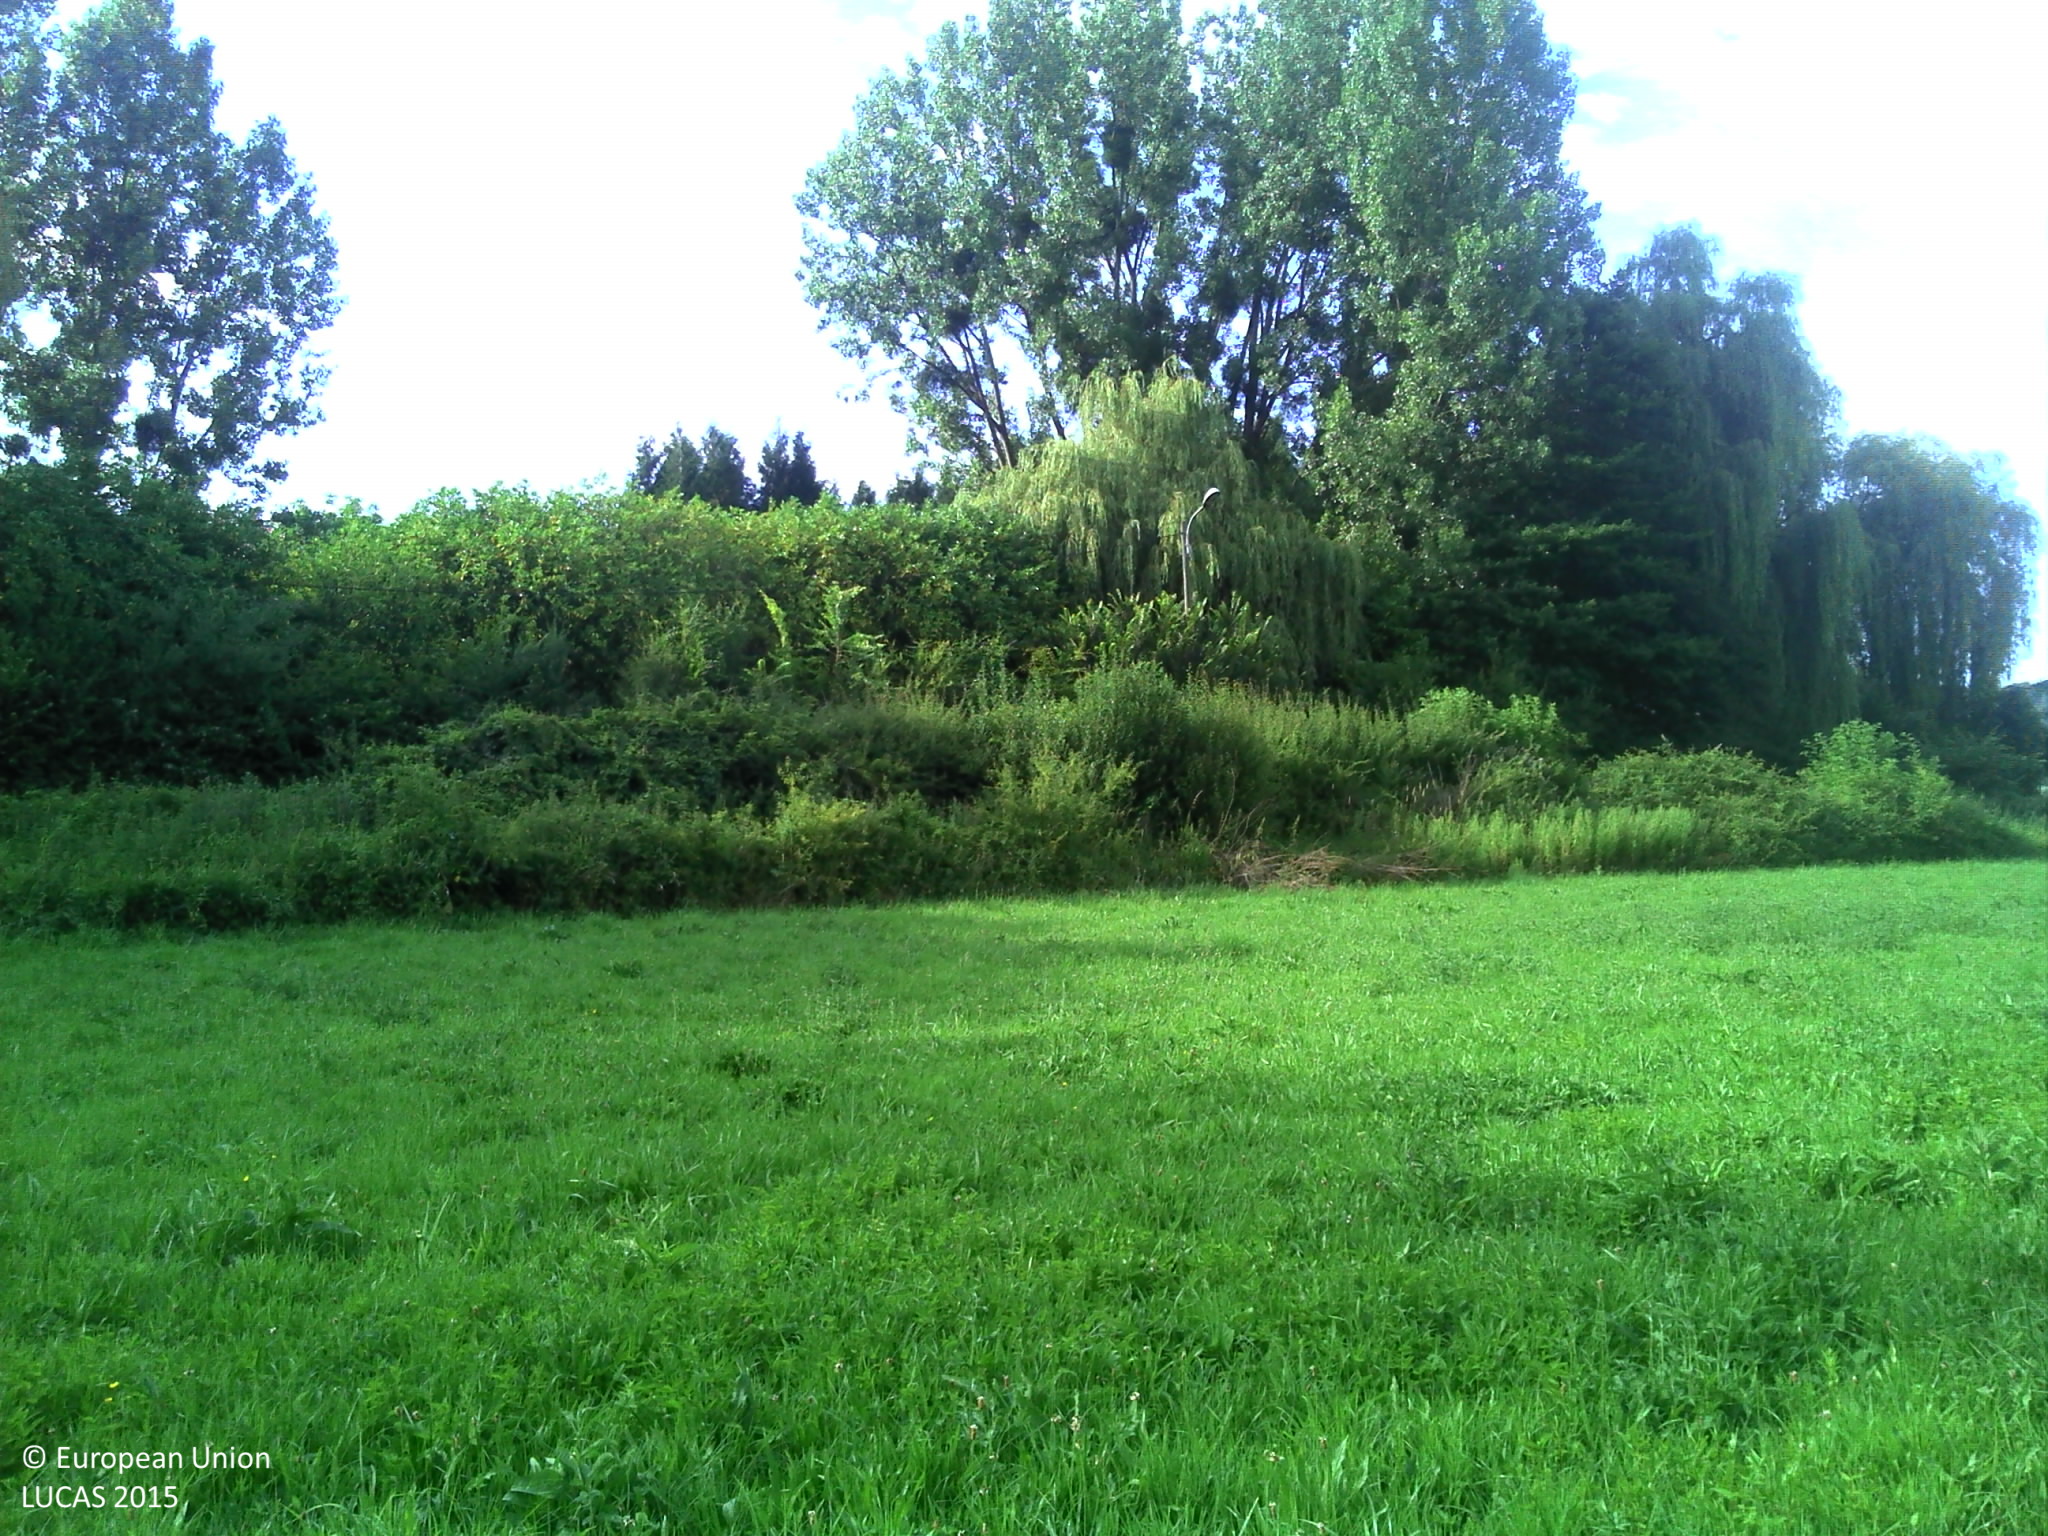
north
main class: Grassland
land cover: Grassland without tree/shrub cover
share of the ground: > 75 %
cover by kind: herbaceous plants 100 %
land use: Agriculture (excluding fallow land and kitchen gardens)
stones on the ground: < 10 %
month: July
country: FR
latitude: 49.3999
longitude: 0.4233
